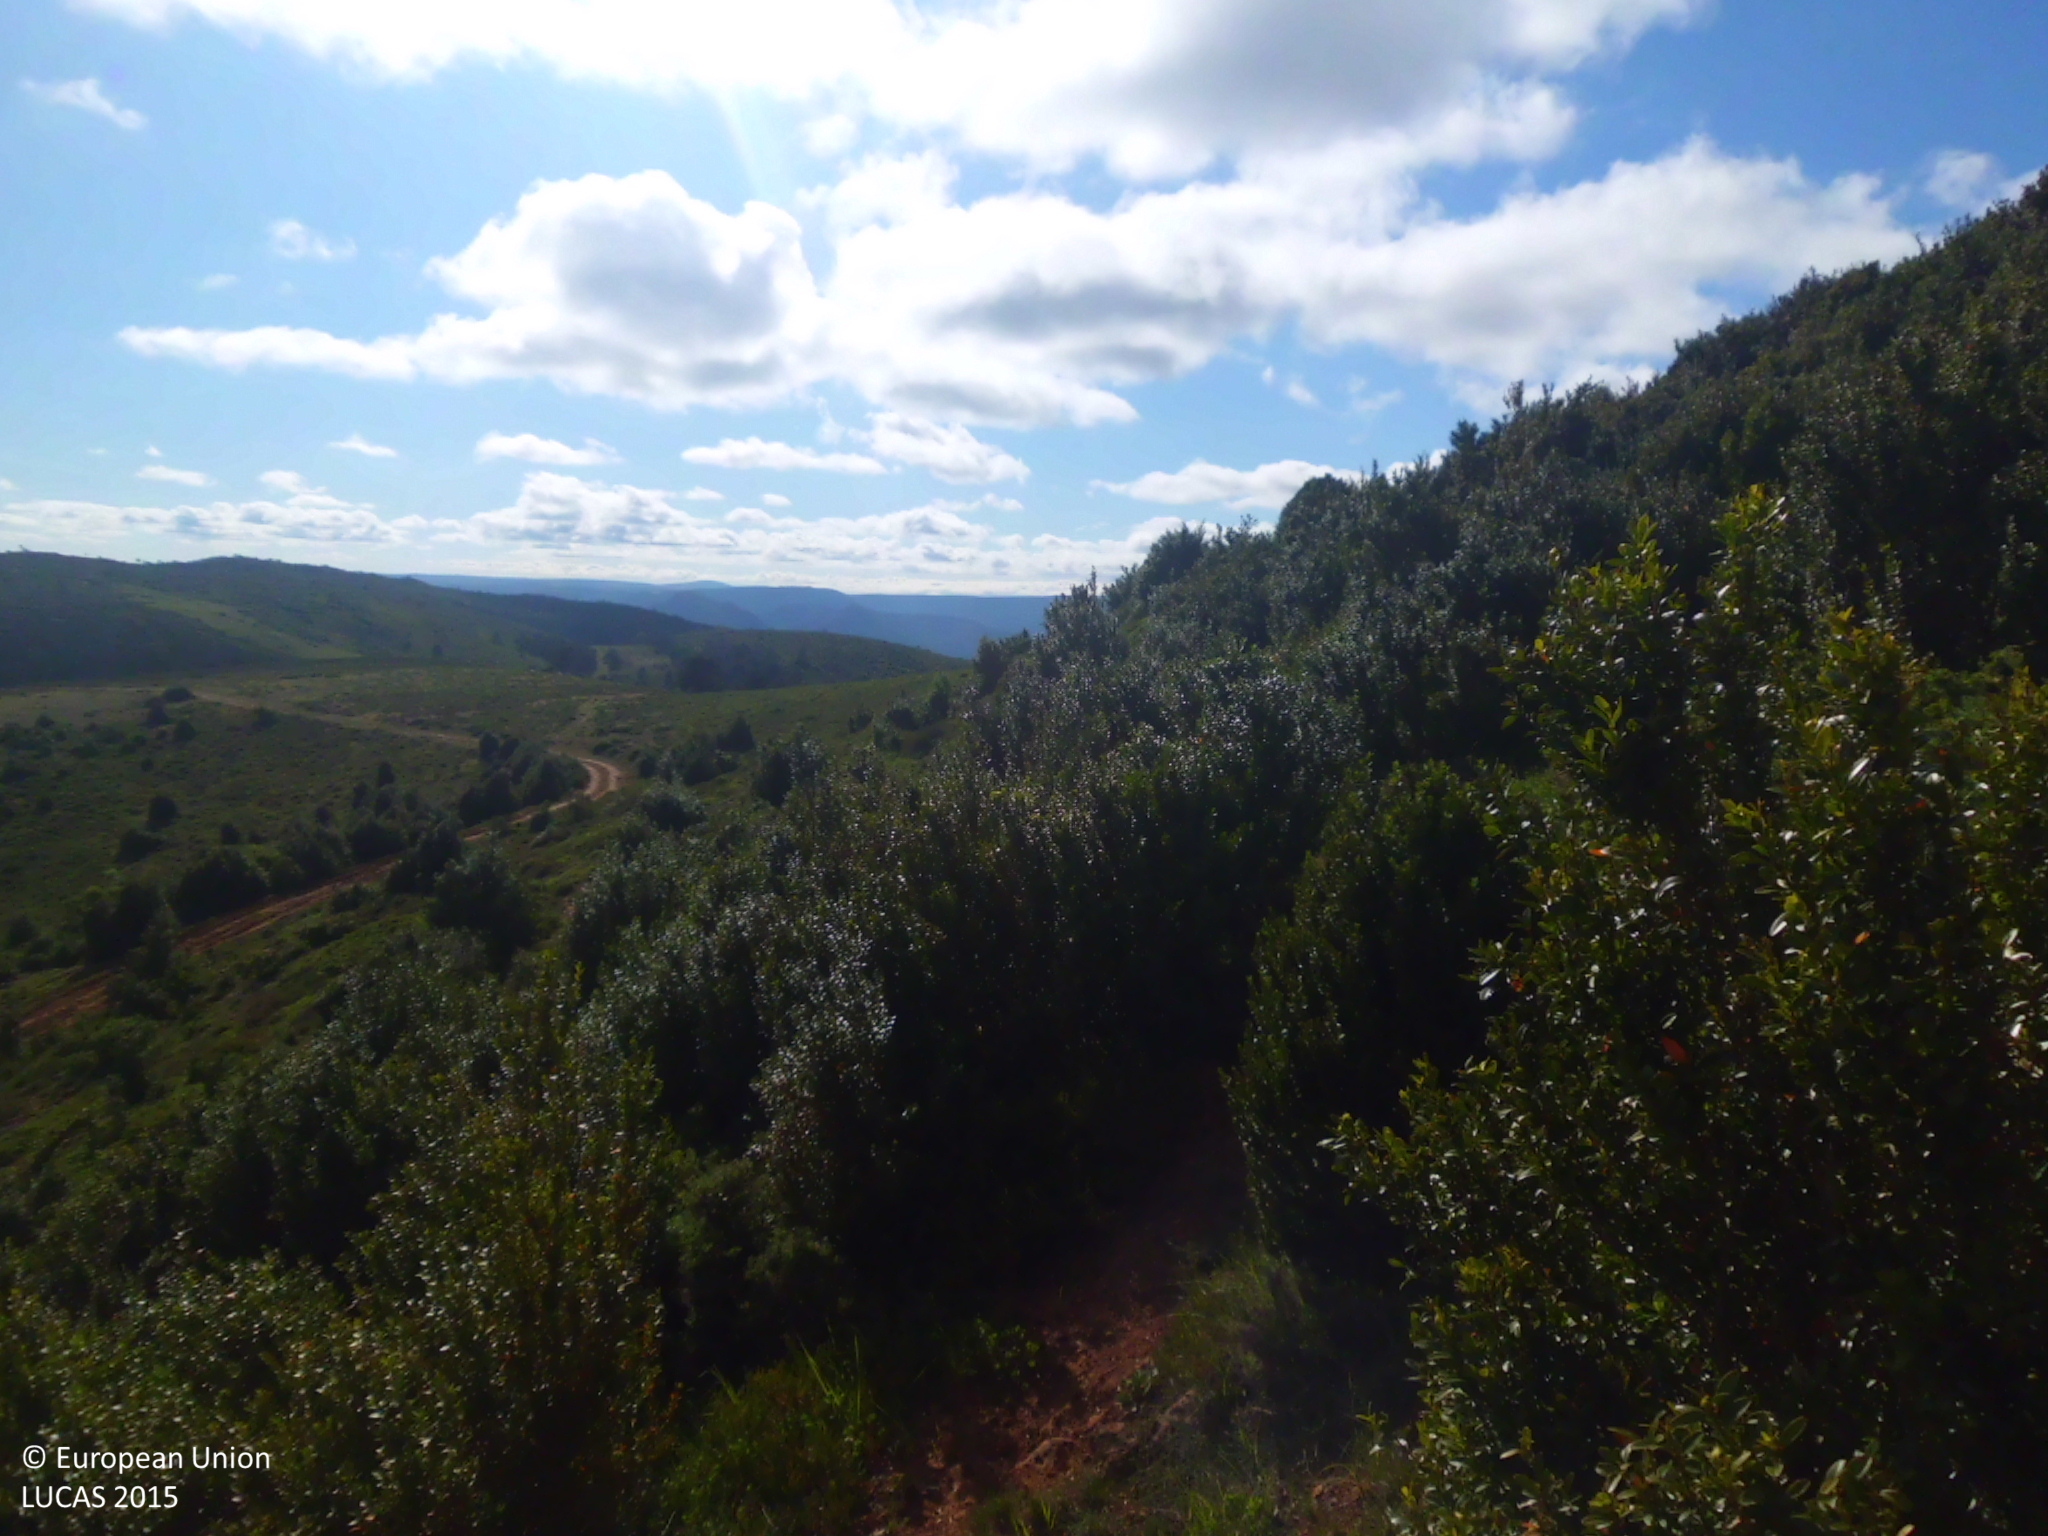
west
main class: Shrubland
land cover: Shrubland with sparse tree cover
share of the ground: > 75 %
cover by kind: shrubs 65 %, herbaceous plants 30 %, broadleaved forest trees 5 %
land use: Semi-natural and natural areas not in use
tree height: < 5 m
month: June
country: ES
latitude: 42.7122
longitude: -3.3807
